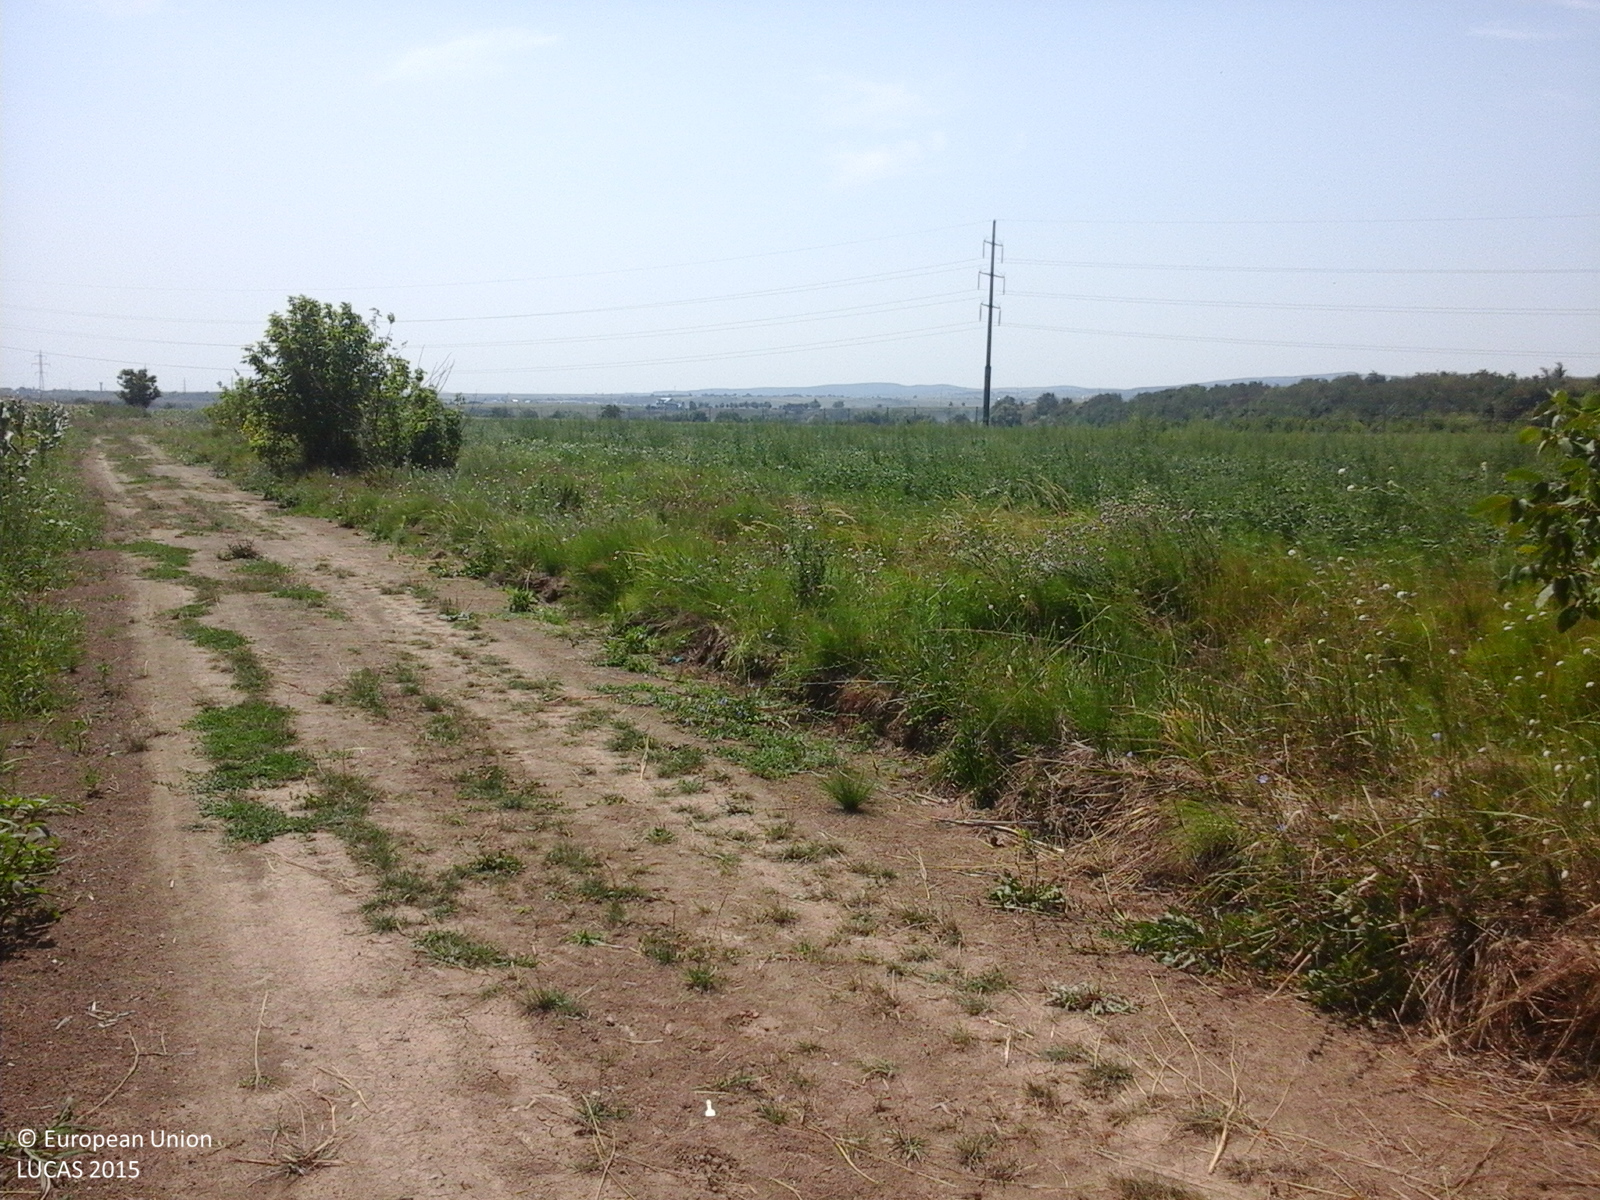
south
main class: Cropland
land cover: Maize
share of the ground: > 75 %
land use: Agriculture (excluding fallow land and kitchen gardens)
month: August
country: RO
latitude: 46.2485
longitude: 27.1014
